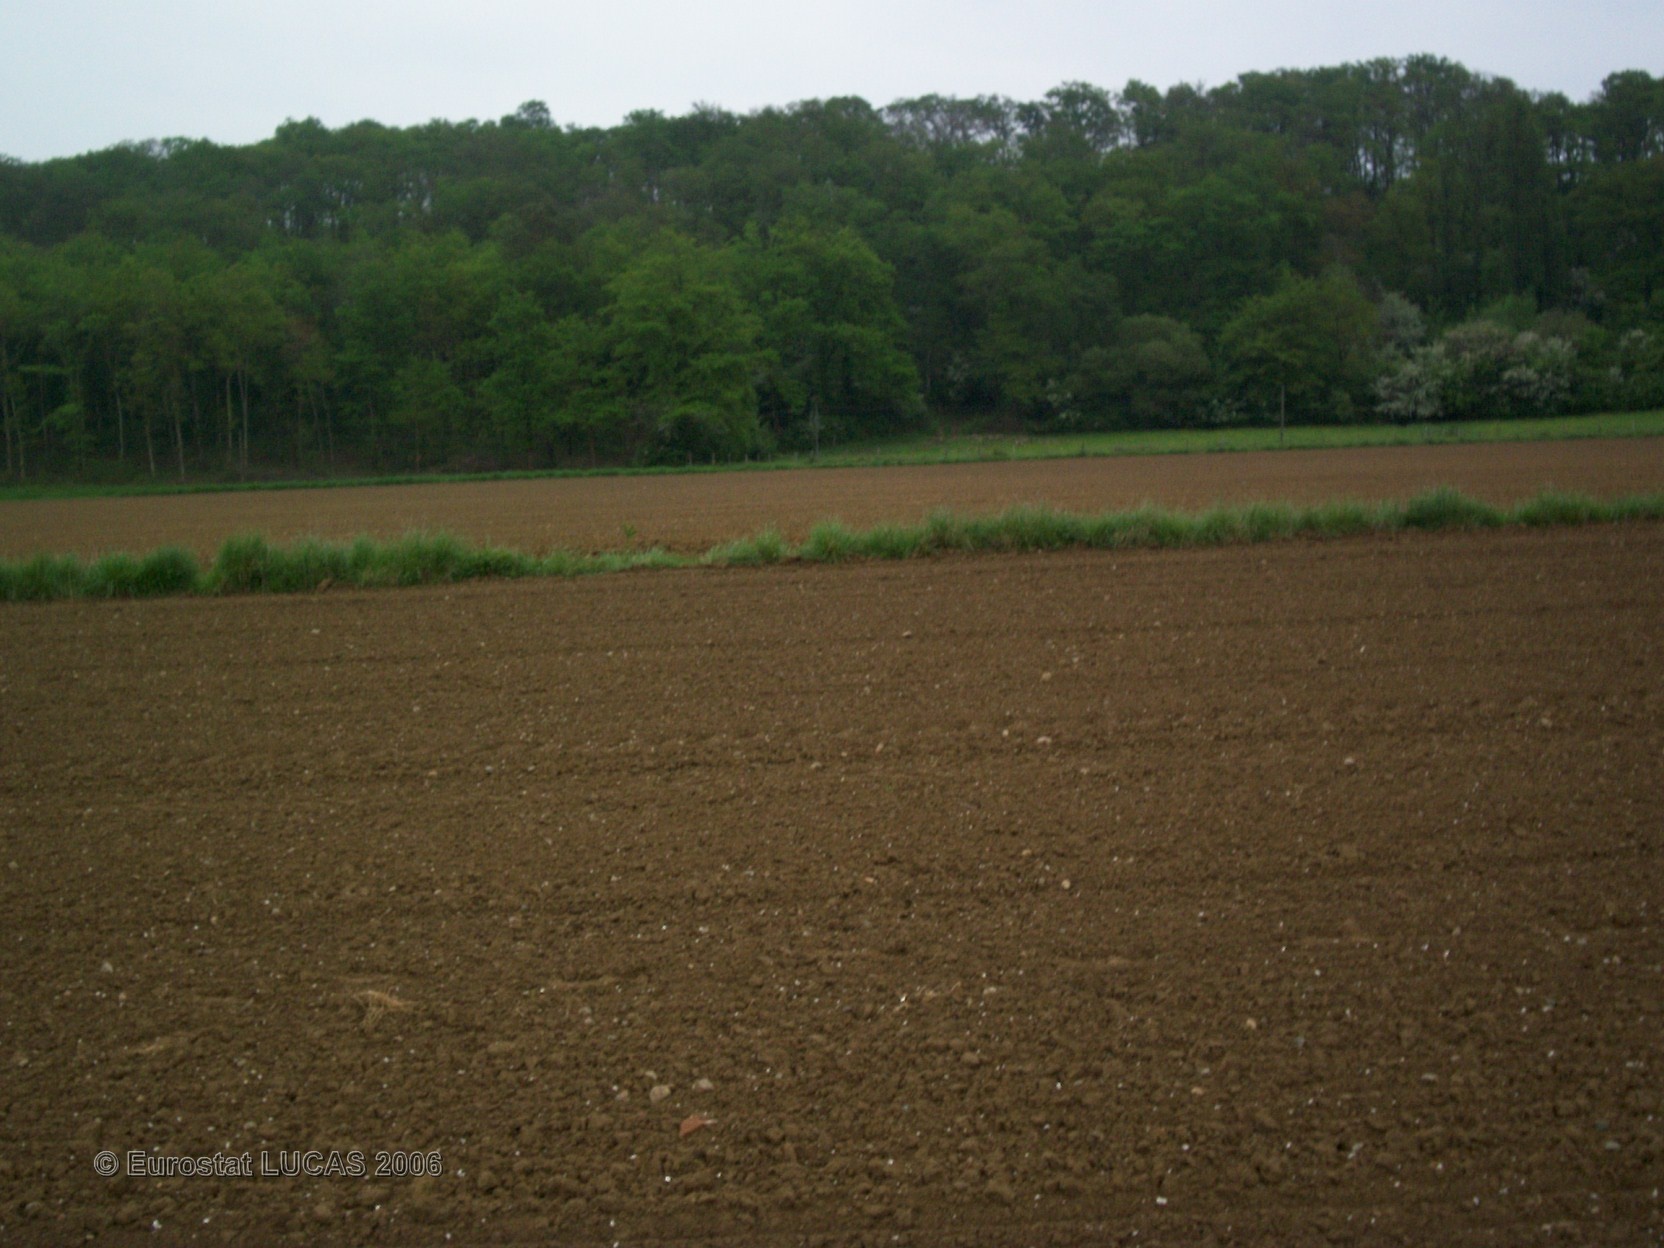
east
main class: Cropland
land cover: Maize
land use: Agriculture (excluding fallow land and kitchen gardens)
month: June
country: FR
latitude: 43.6845
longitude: -0.3678
